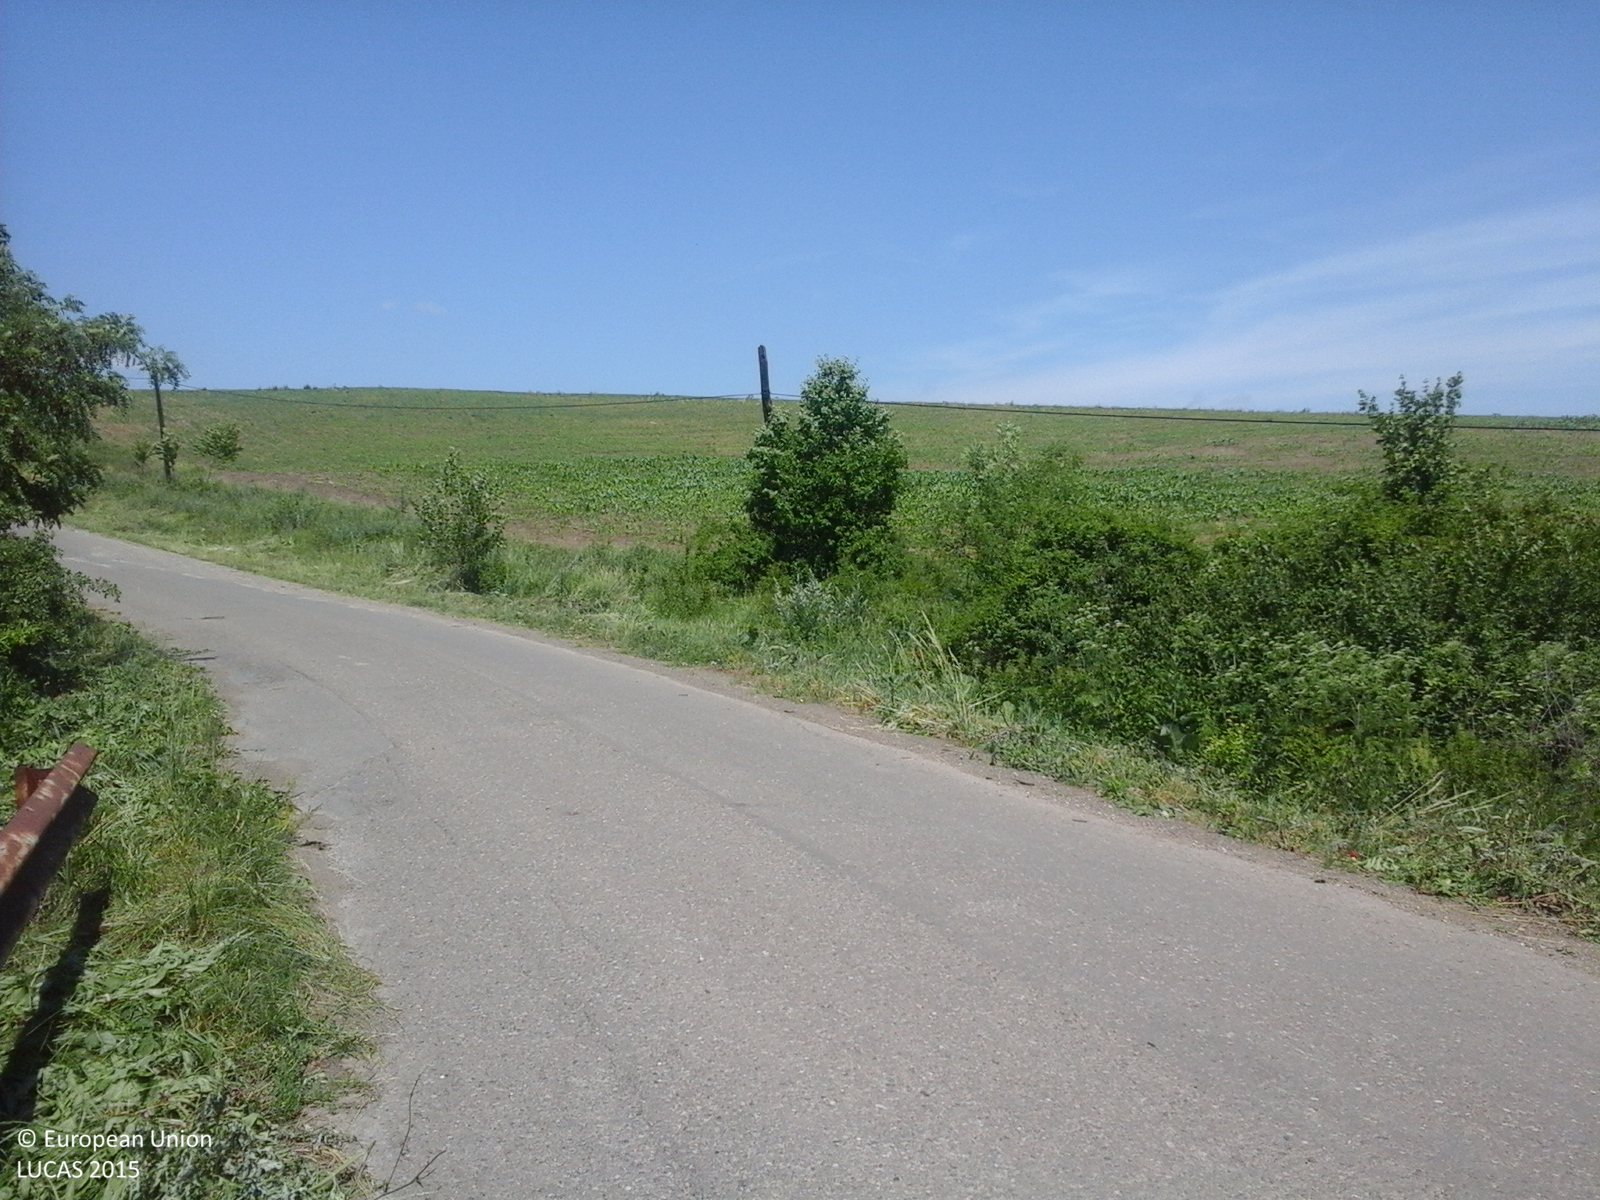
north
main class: Shrubland
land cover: Shrubland with sparse tree cover
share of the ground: > 75 %
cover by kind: shrubs 95 %, broadleaved forest trees 5 %
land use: Abandoned areas
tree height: > 5 m
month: June
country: RO
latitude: 47.7975
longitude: 27.0760
